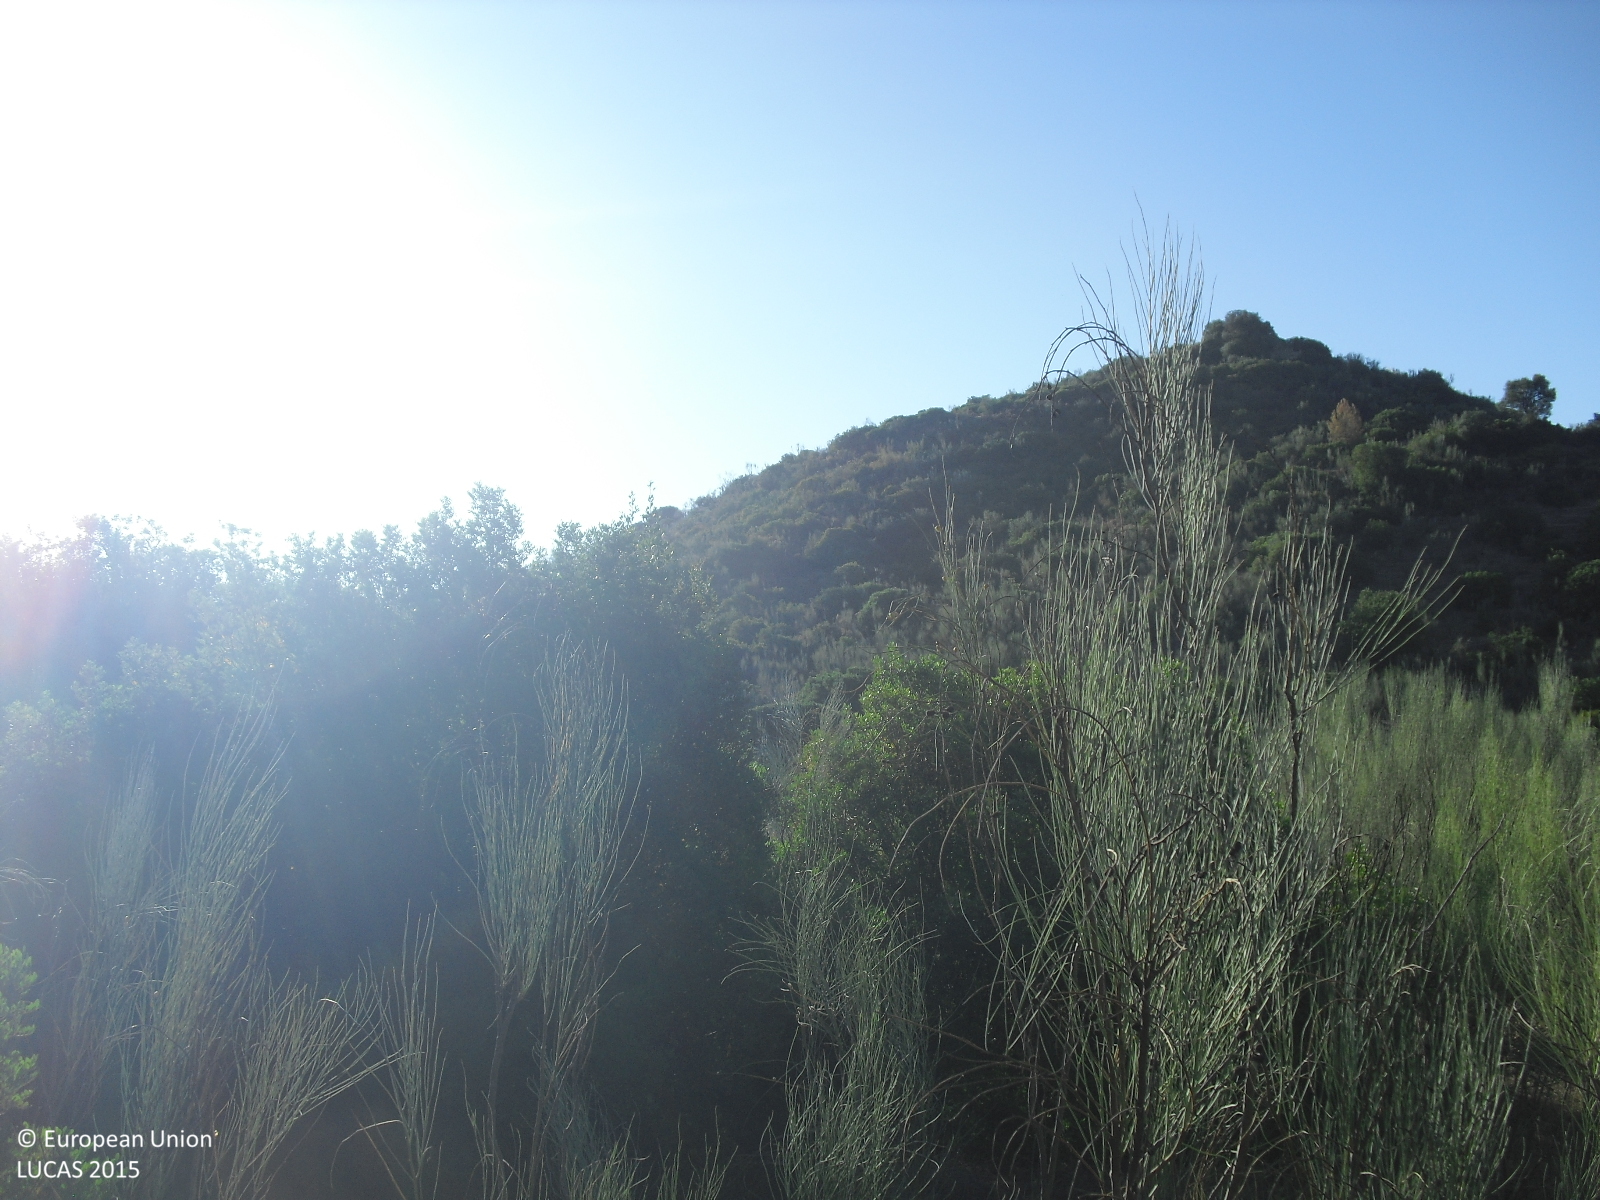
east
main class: Shrubland
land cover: Shrubland with sparse tree cover
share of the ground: 50 - 75 %
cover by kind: shrubs 50 %, herbaceous plants 45 %, broadleaved forest trees 5 %
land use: Agriculture (excluding fallow land and kitchen gardens)
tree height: < 5 m
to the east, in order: Shrubland with sparse tree cover; Tracks; Shrubland without tree cover
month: July
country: ES
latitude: 36.9881
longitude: -5.3651
